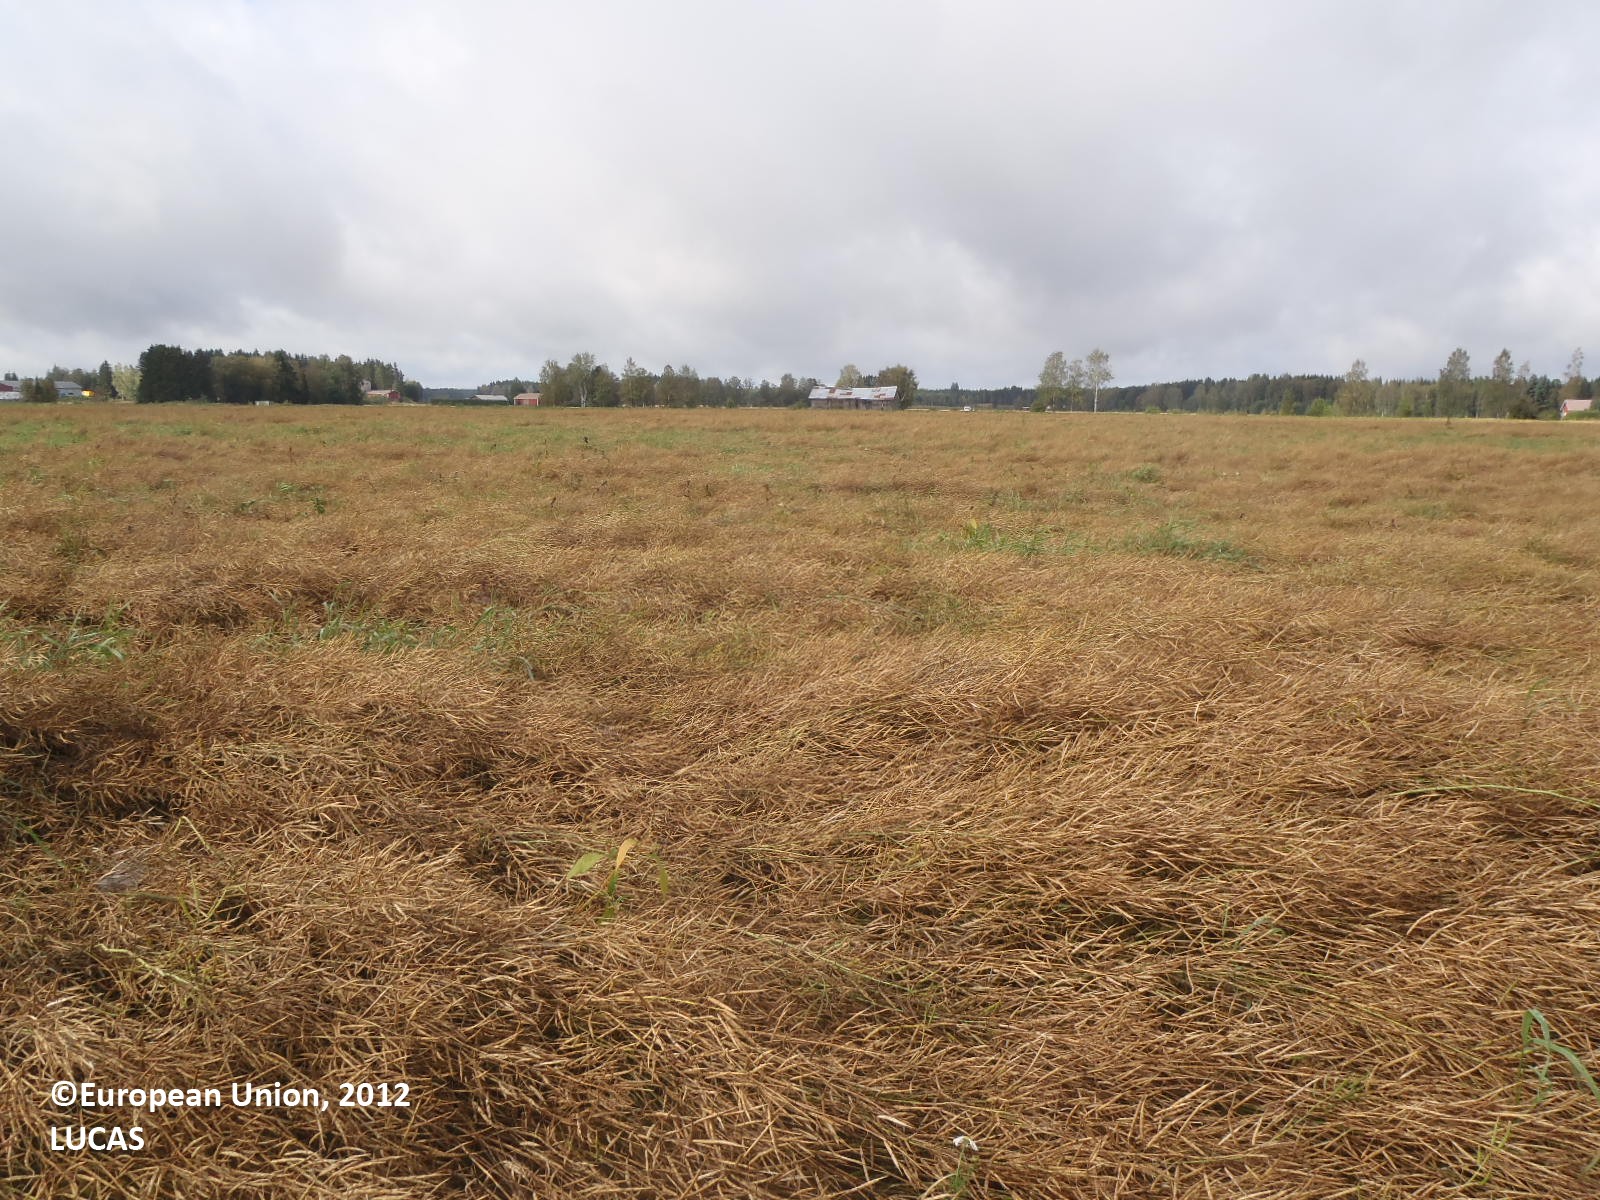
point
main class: Cropland
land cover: Rape and turnip rape
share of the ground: > 75 %
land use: Agriculture (excluding fallow land and kitchen gardens)
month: September
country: FI
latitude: 60.9672
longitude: 22.5737
